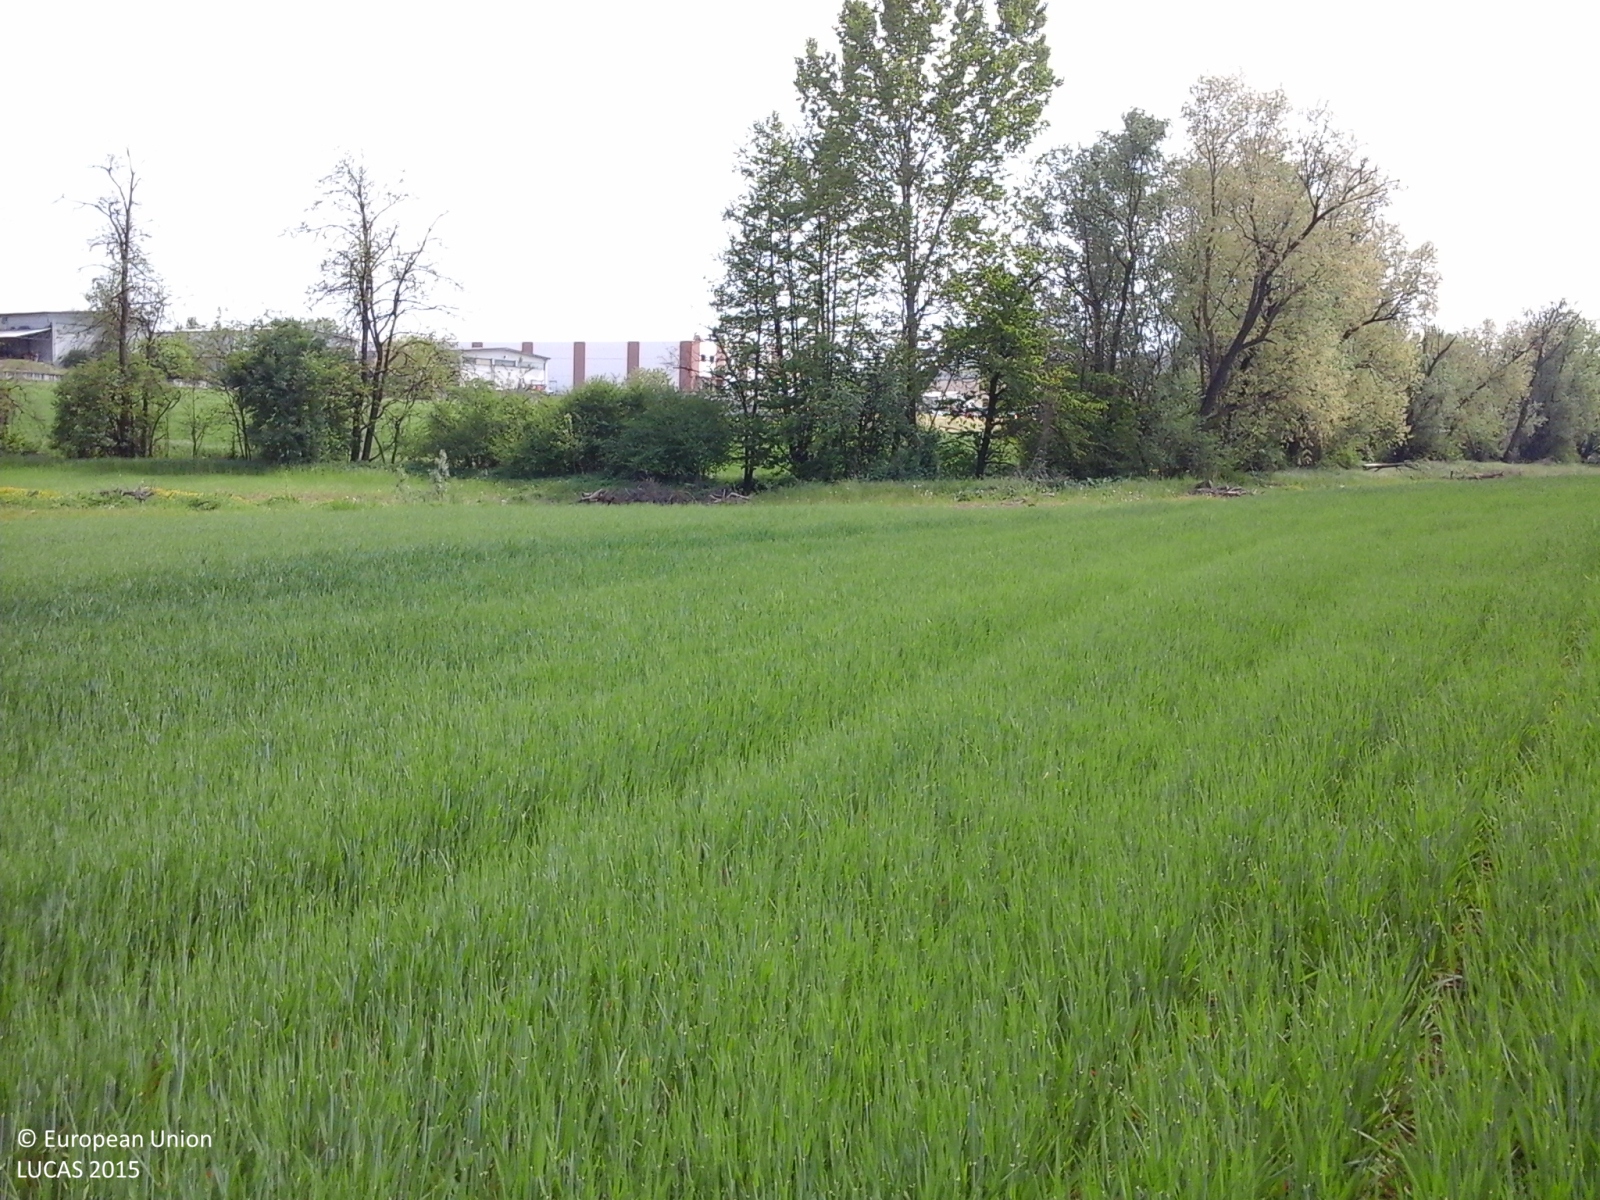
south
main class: Cropland
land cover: Common wheat
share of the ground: > 75 %
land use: Agriculture (excluding fallow land and kitchen gardens)
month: April
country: IT
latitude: 45.0160
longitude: 9.4048
